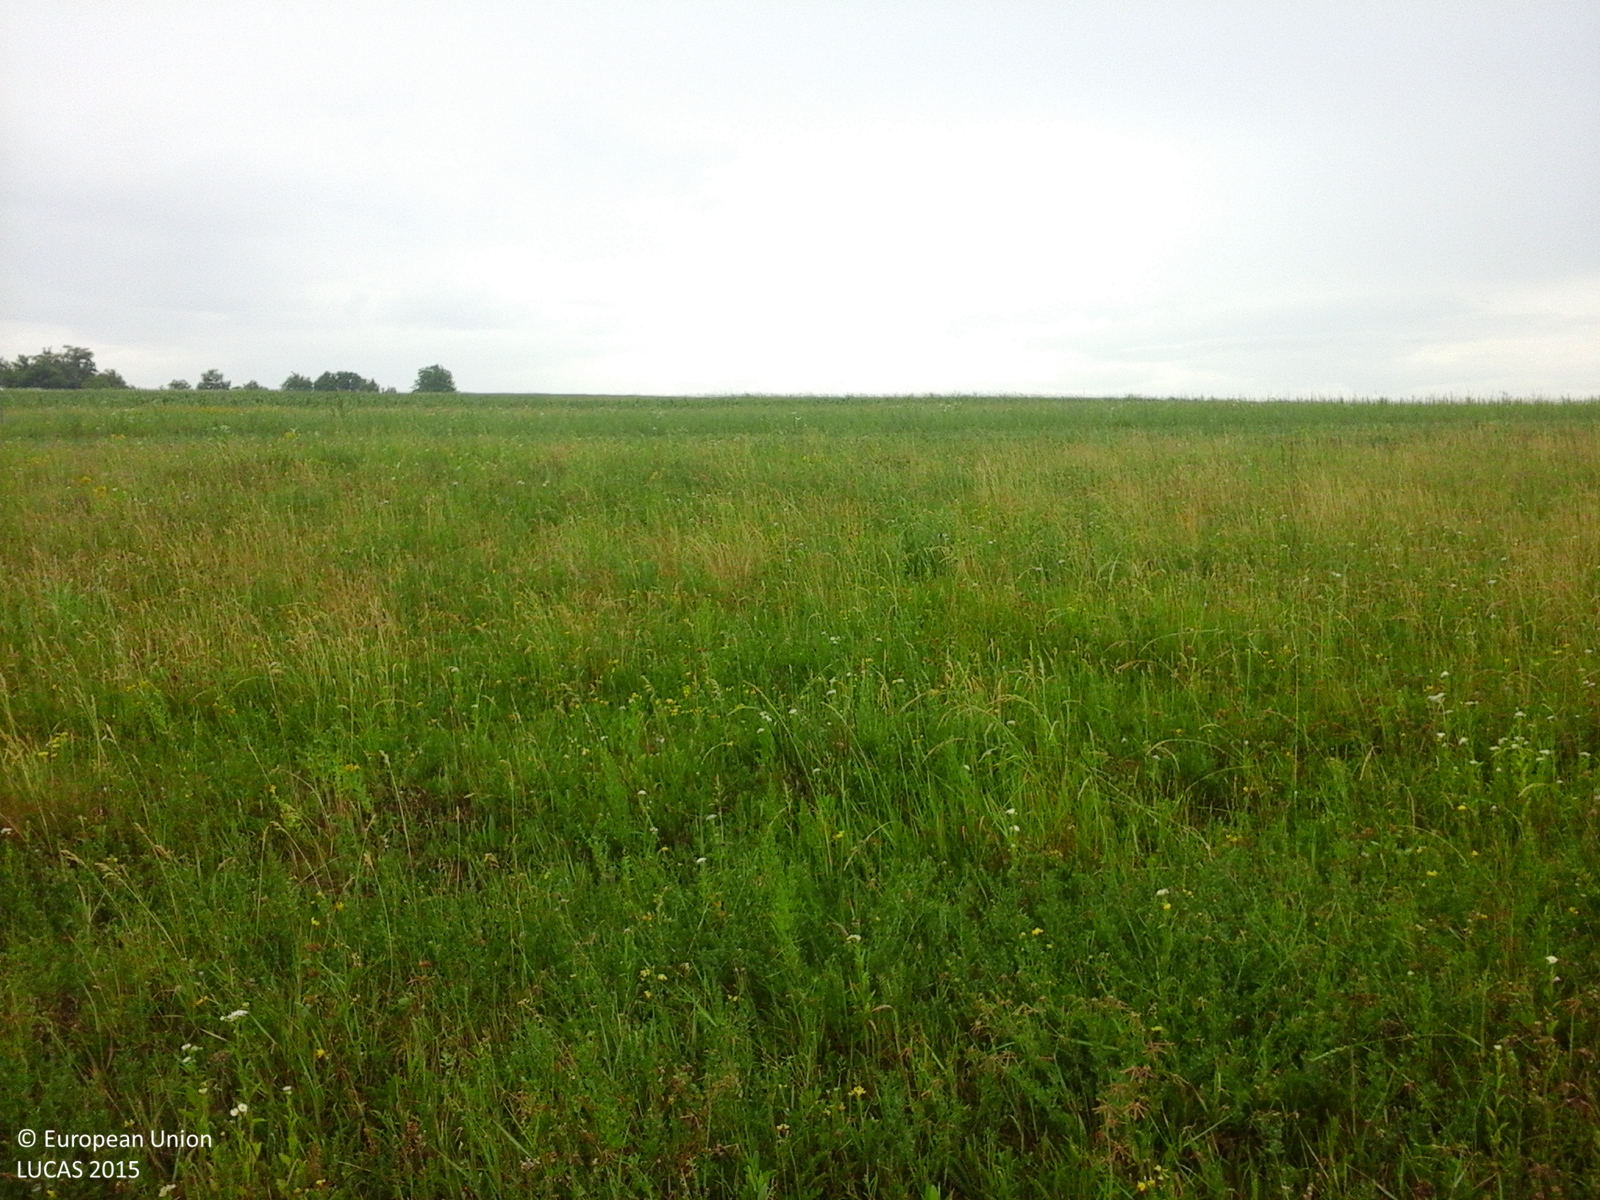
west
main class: Grassland
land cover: Grassland without tree/shrub cover
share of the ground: > 75 %
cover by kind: herbaceous plants 100 %
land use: Agriculture (excluding fallow land and kitchen gardens)
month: June
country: RO
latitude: 47.3598
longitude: 26.4650
